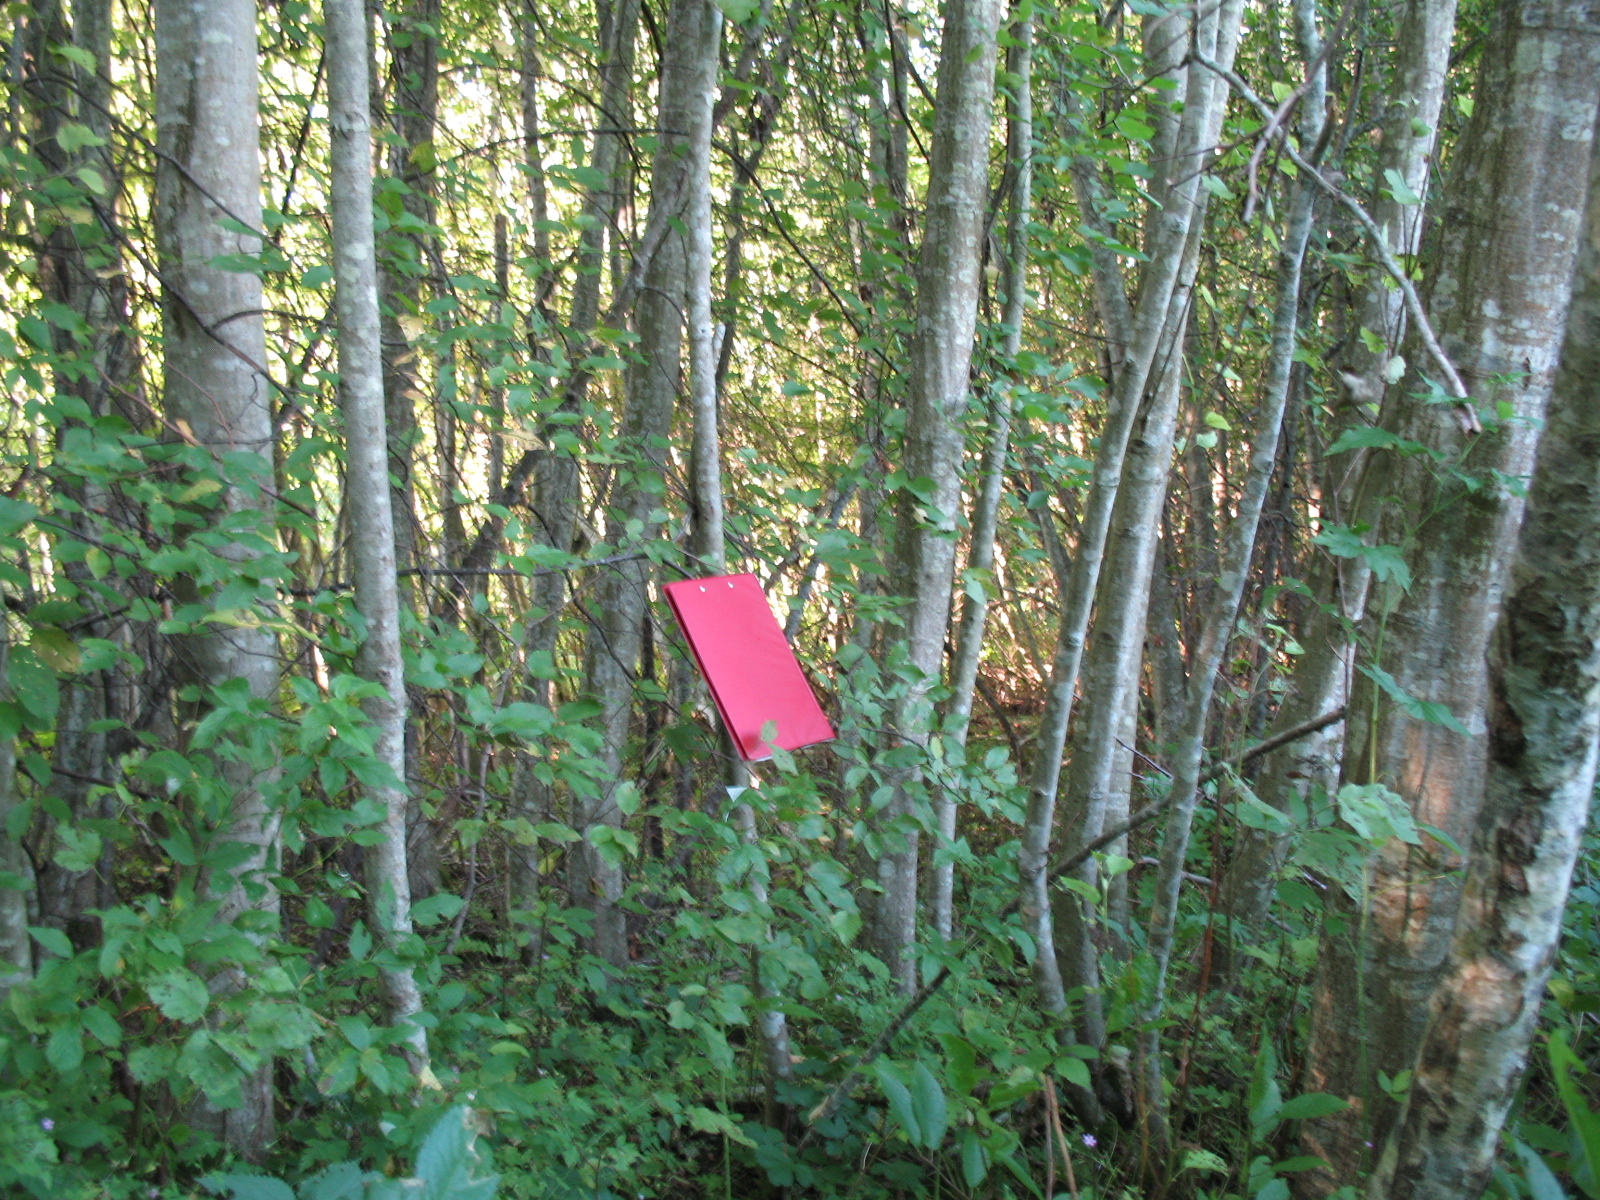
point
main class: Woodland
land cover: Broadleaved woodland
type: non-riverine alder, birch or aspen forest
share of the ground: > 75 %
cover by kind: broadleaved forest trees 90 %, shrubs 5 %, herbaceous plants 5 %
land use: Forestry
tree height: > 5 m
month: August
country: LV
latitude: 56.2506
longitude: 25.4691
